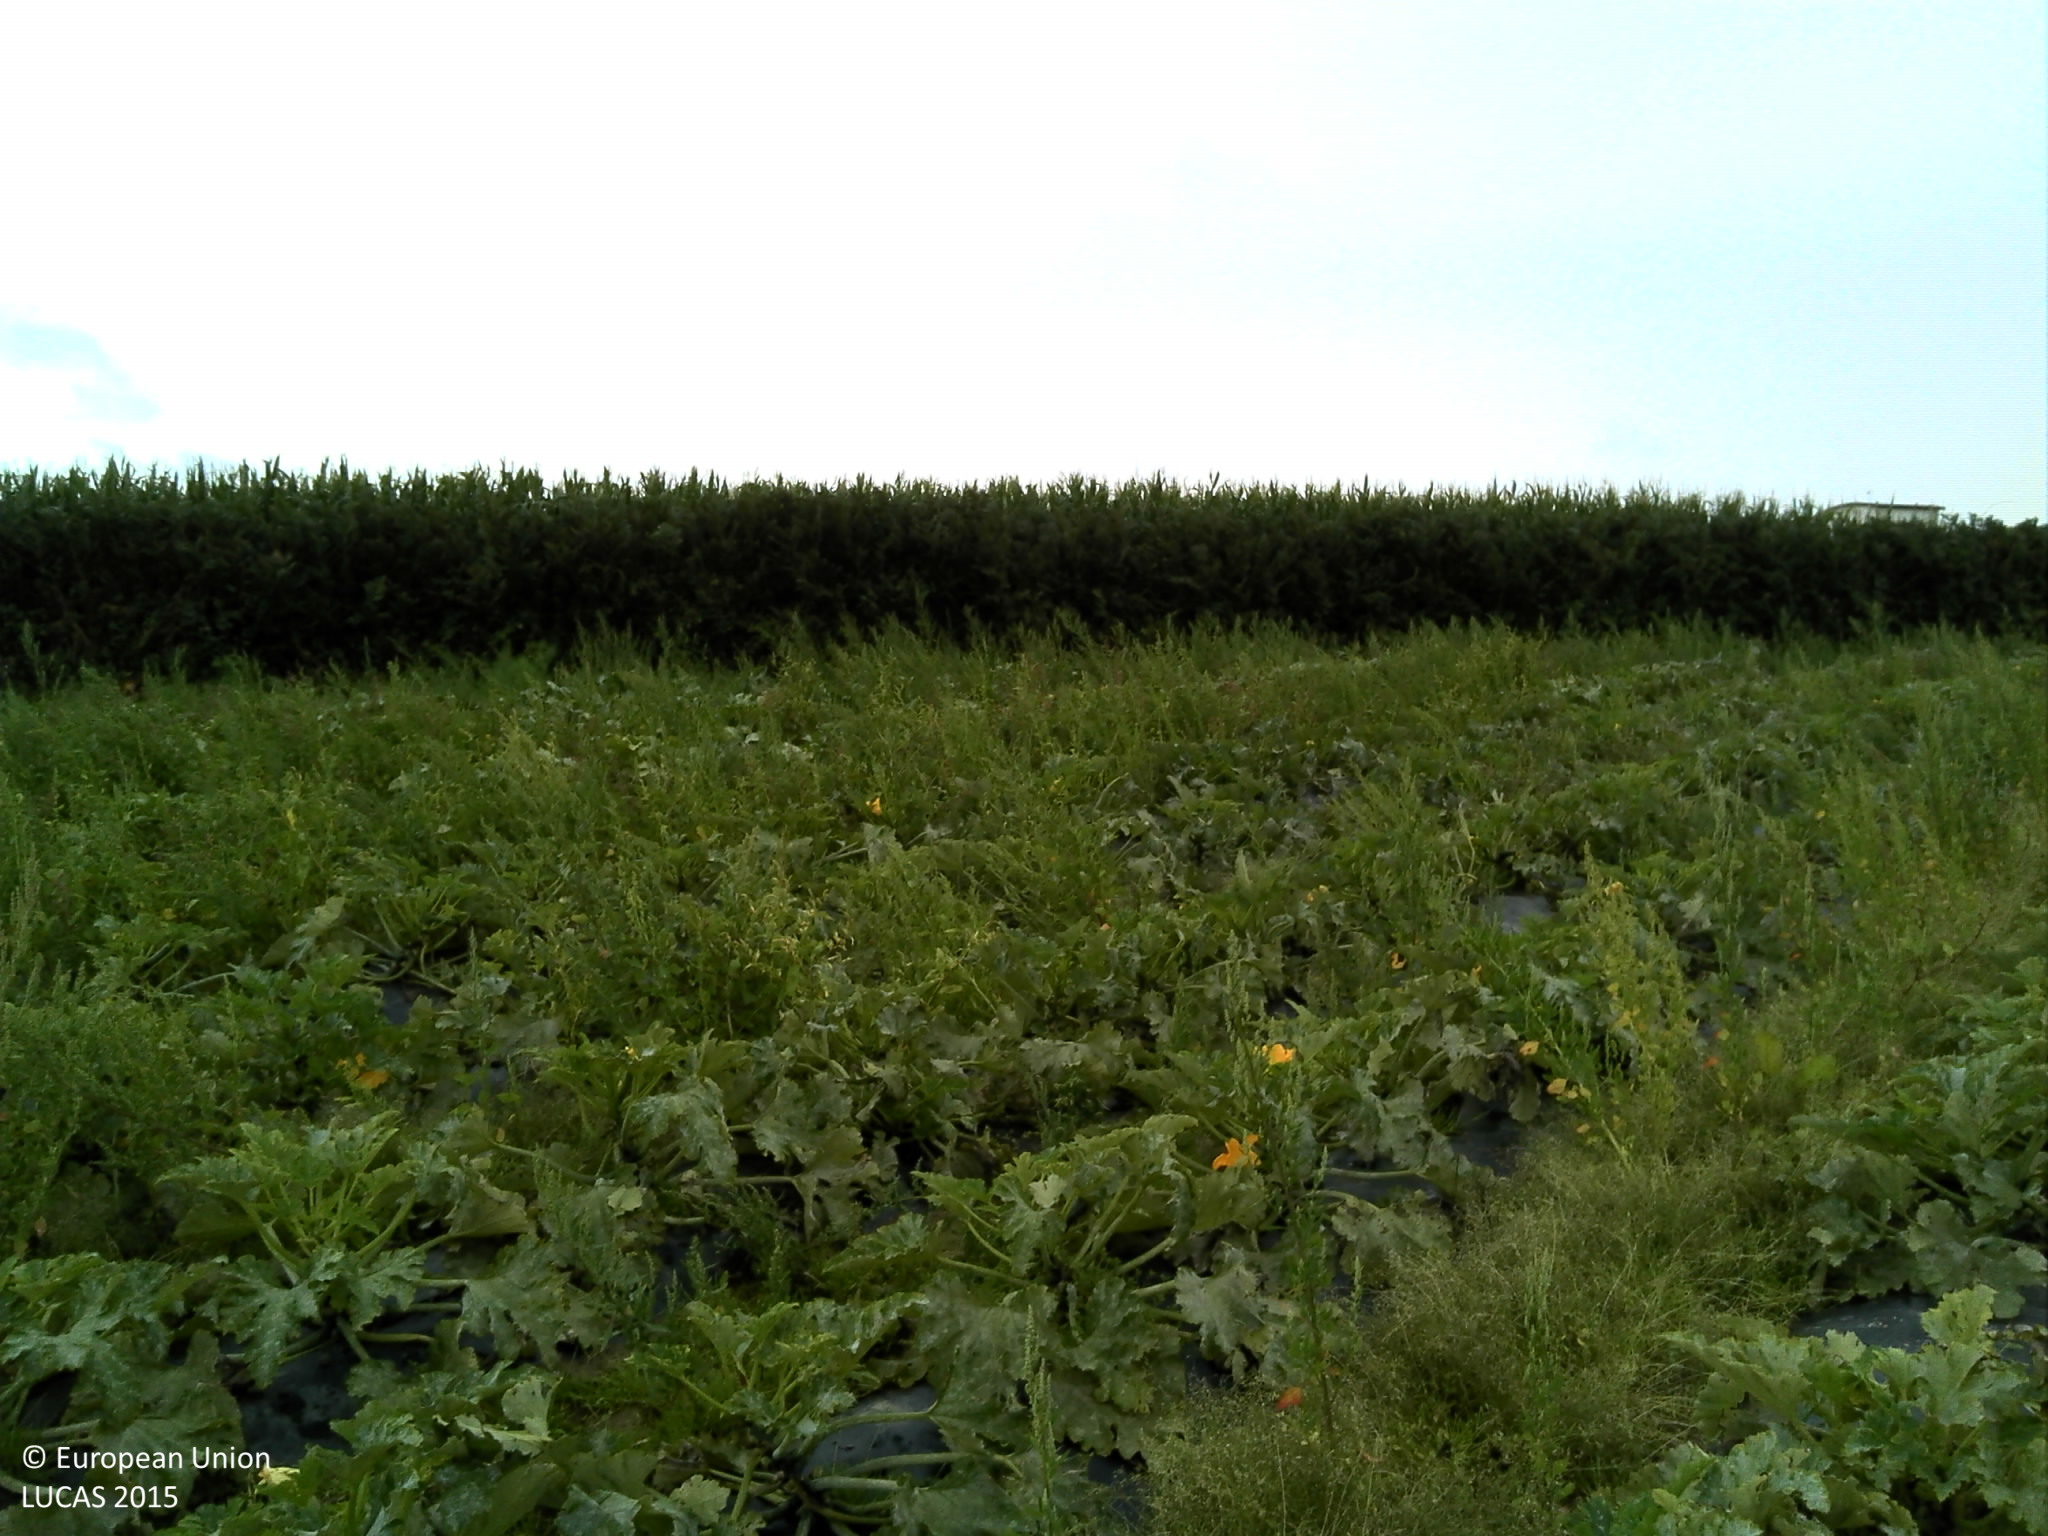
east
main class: Cropland
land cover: Other fresh vegetables
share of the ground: 50 - 75 %
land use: Agriculture (excluding fallow land and kitchen gardens)
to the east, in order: Other fresh vegetables; Abandoned hedges; Maize; Abandoned hedges; Other bare soil; Abandoned hedges; Maize; Artificial constructions in urban areas
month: August
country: FR
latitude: 48.6088
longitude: -4.5172
